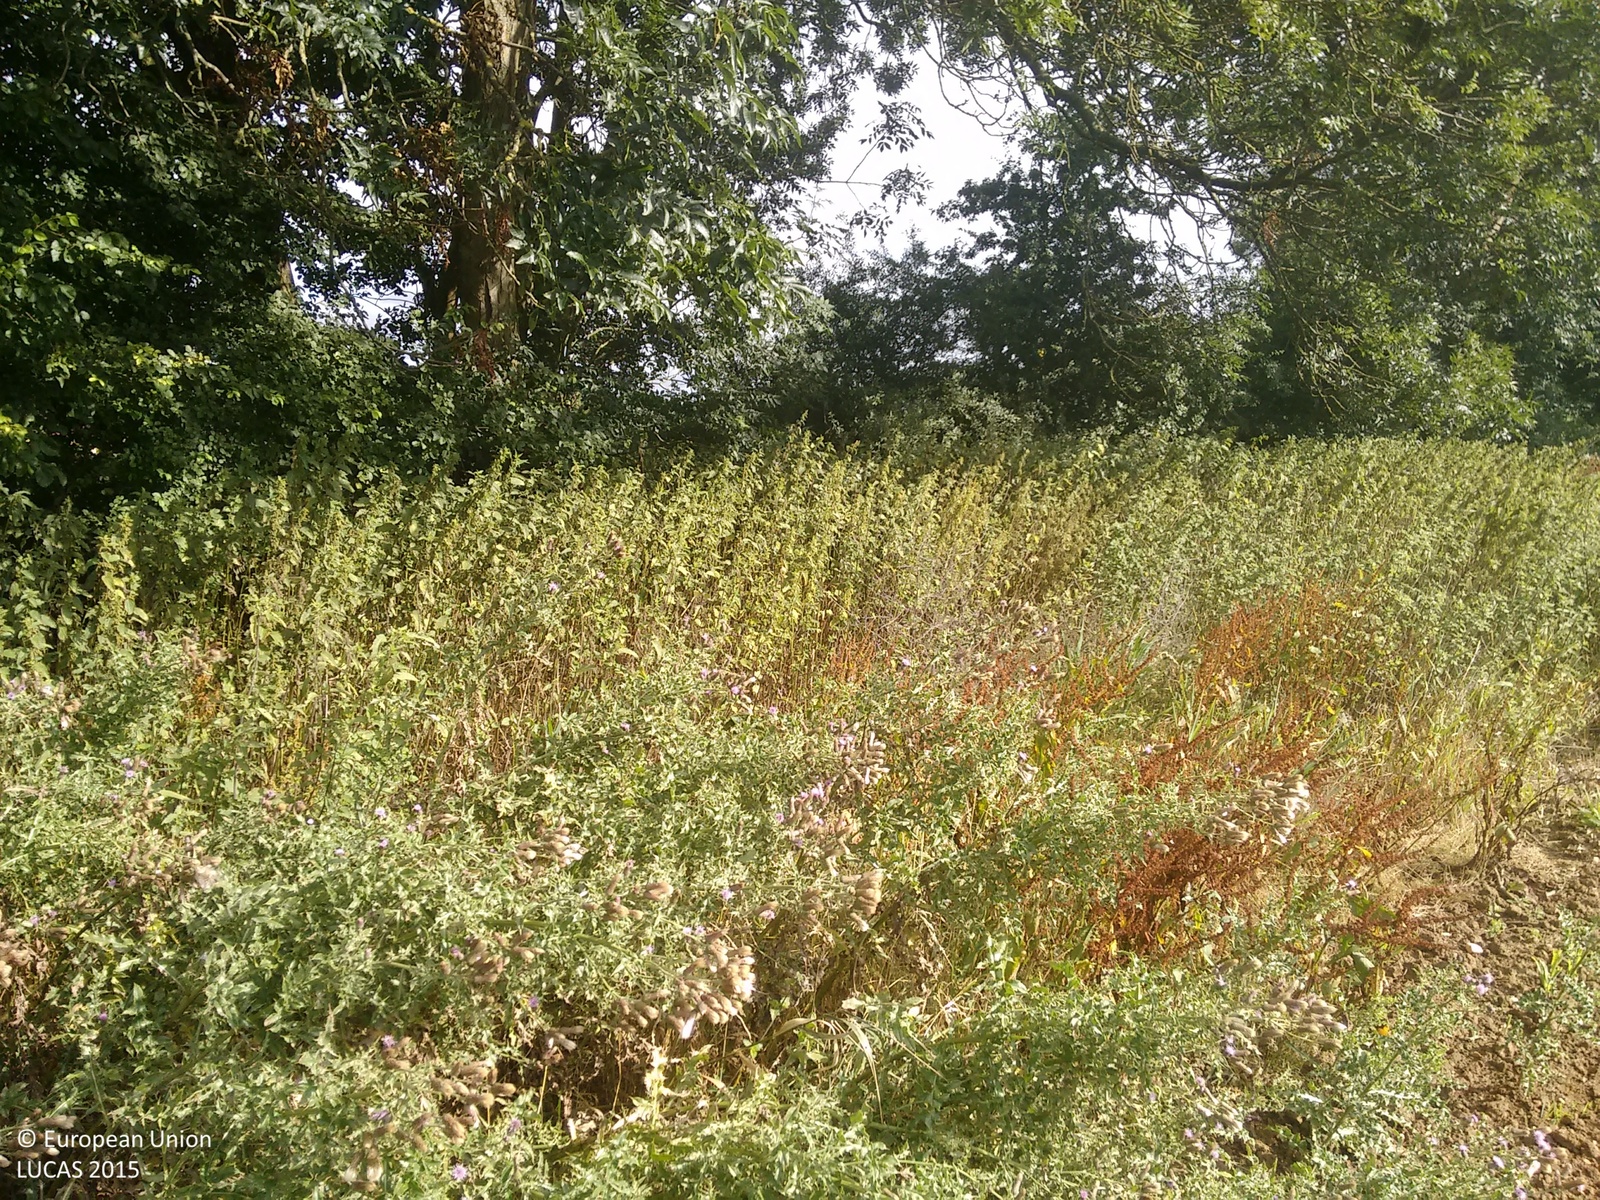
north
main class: Cropland
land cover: Maize
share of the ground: > 75 %
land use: Agriculture (excluding fallow land and kitchen gardens)
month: July
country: GB
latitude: 51.6792
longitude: 0.6160
